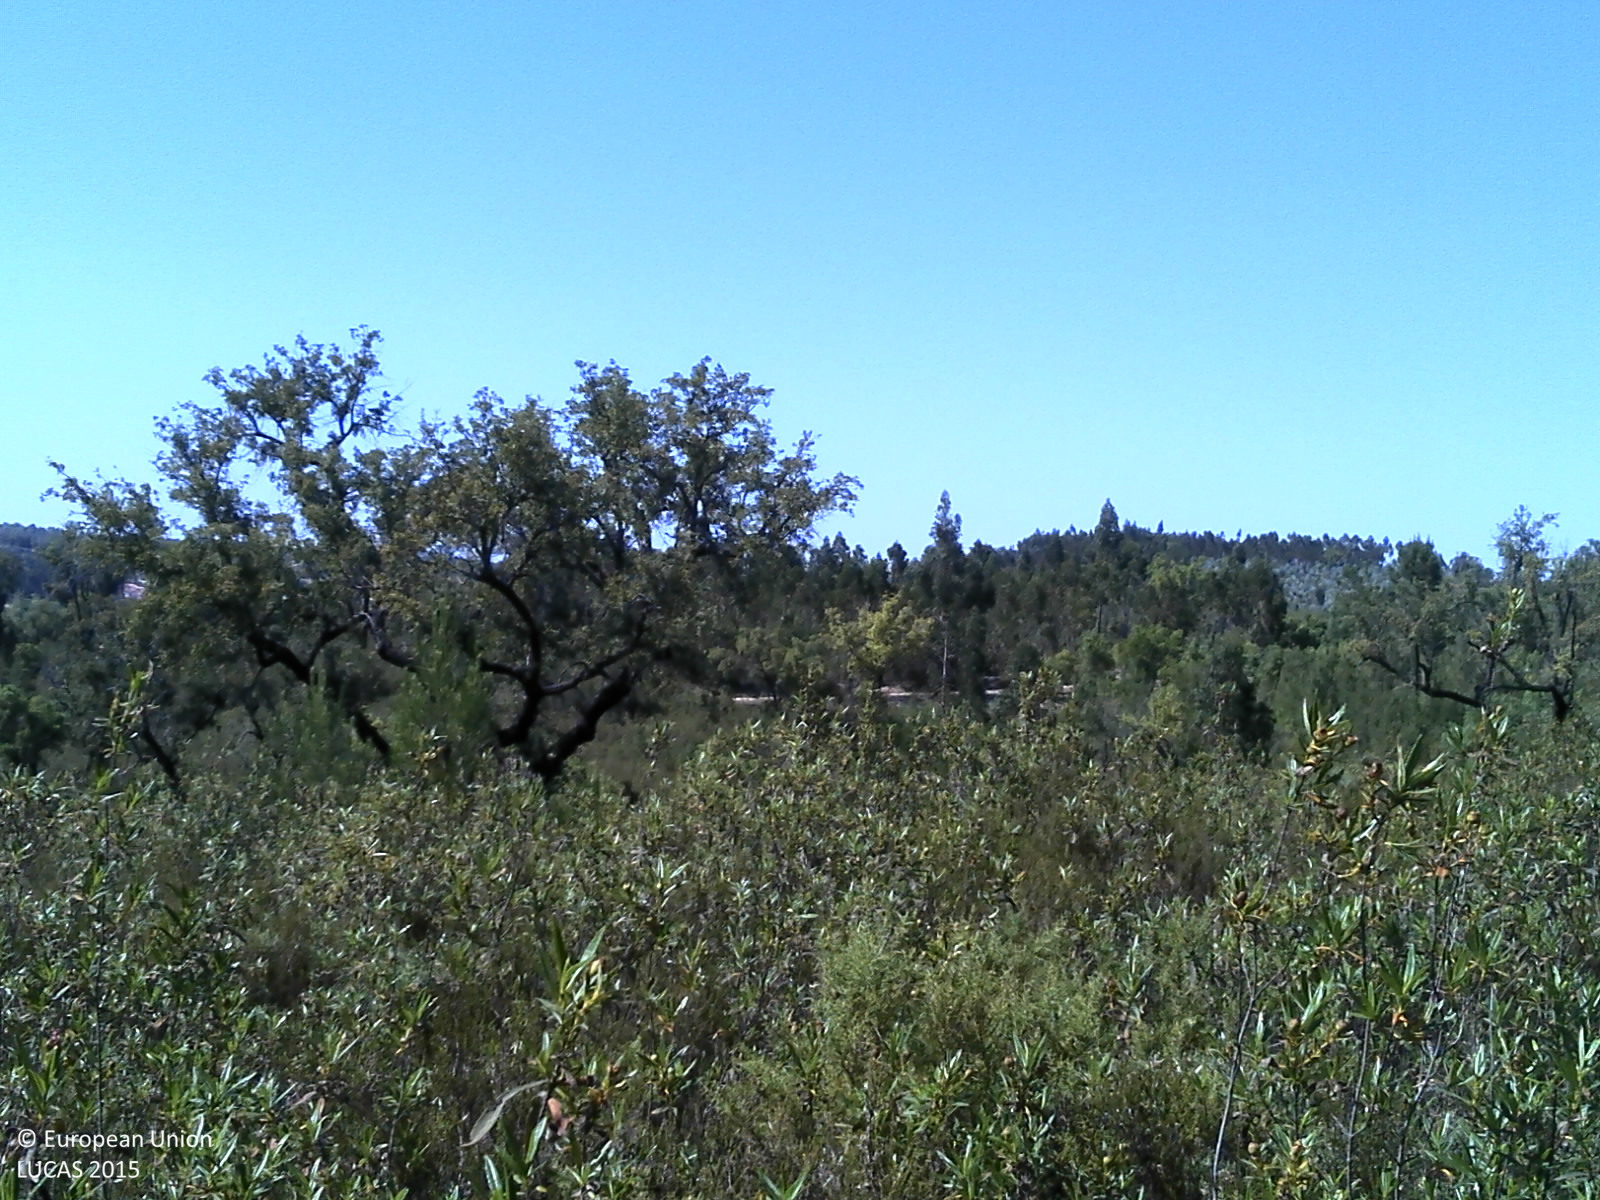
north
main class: Woodland
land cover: Broadleaved woodland
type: broadleaved evergreen forest
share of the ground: 10 - 25 %
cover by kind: shrubs 75 %, broadleaved forest trees 25 %
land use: Forestry
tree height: > 5 m
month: May
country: PT
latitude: 39.3648
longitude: -7.8932
